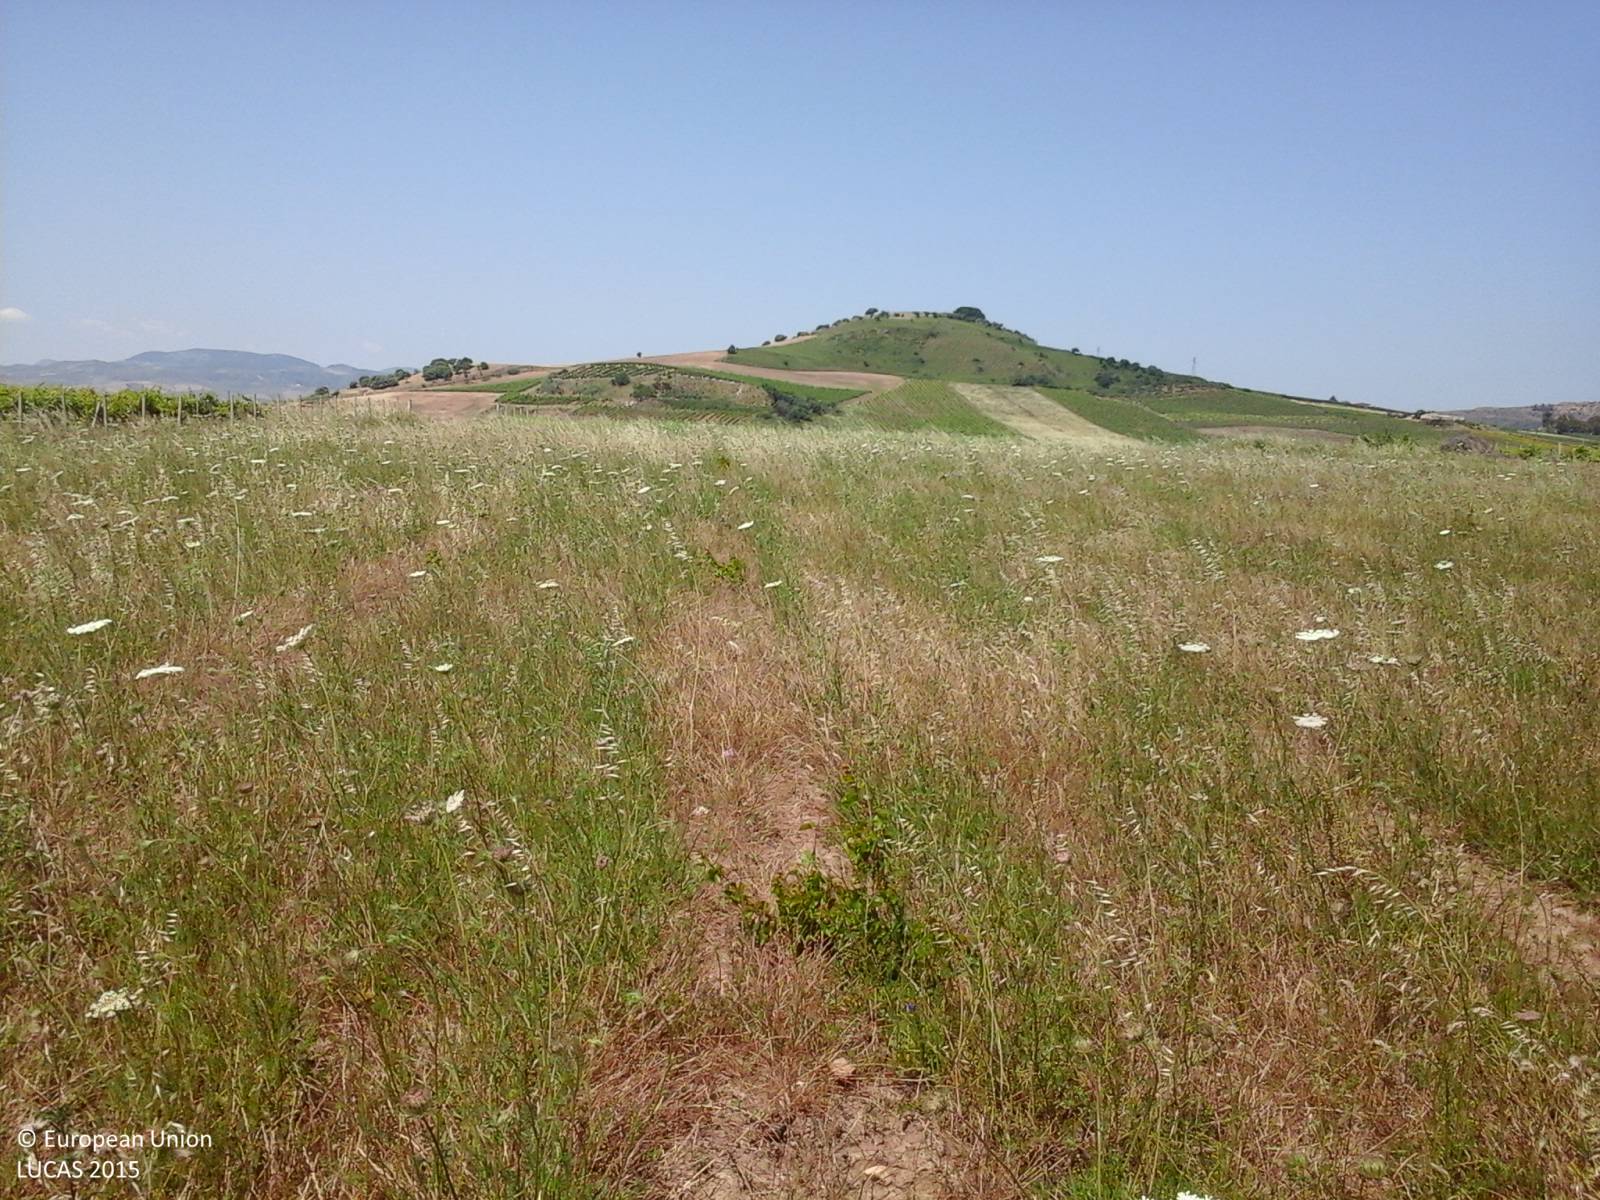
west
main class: Grassland
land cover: Grassland without tree/shrub cover
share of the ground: > 75 %
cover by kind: herbaceous plants 100 %
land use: Abandoned areas
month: June
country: IT
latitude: 37.9184
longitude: 12.9927
